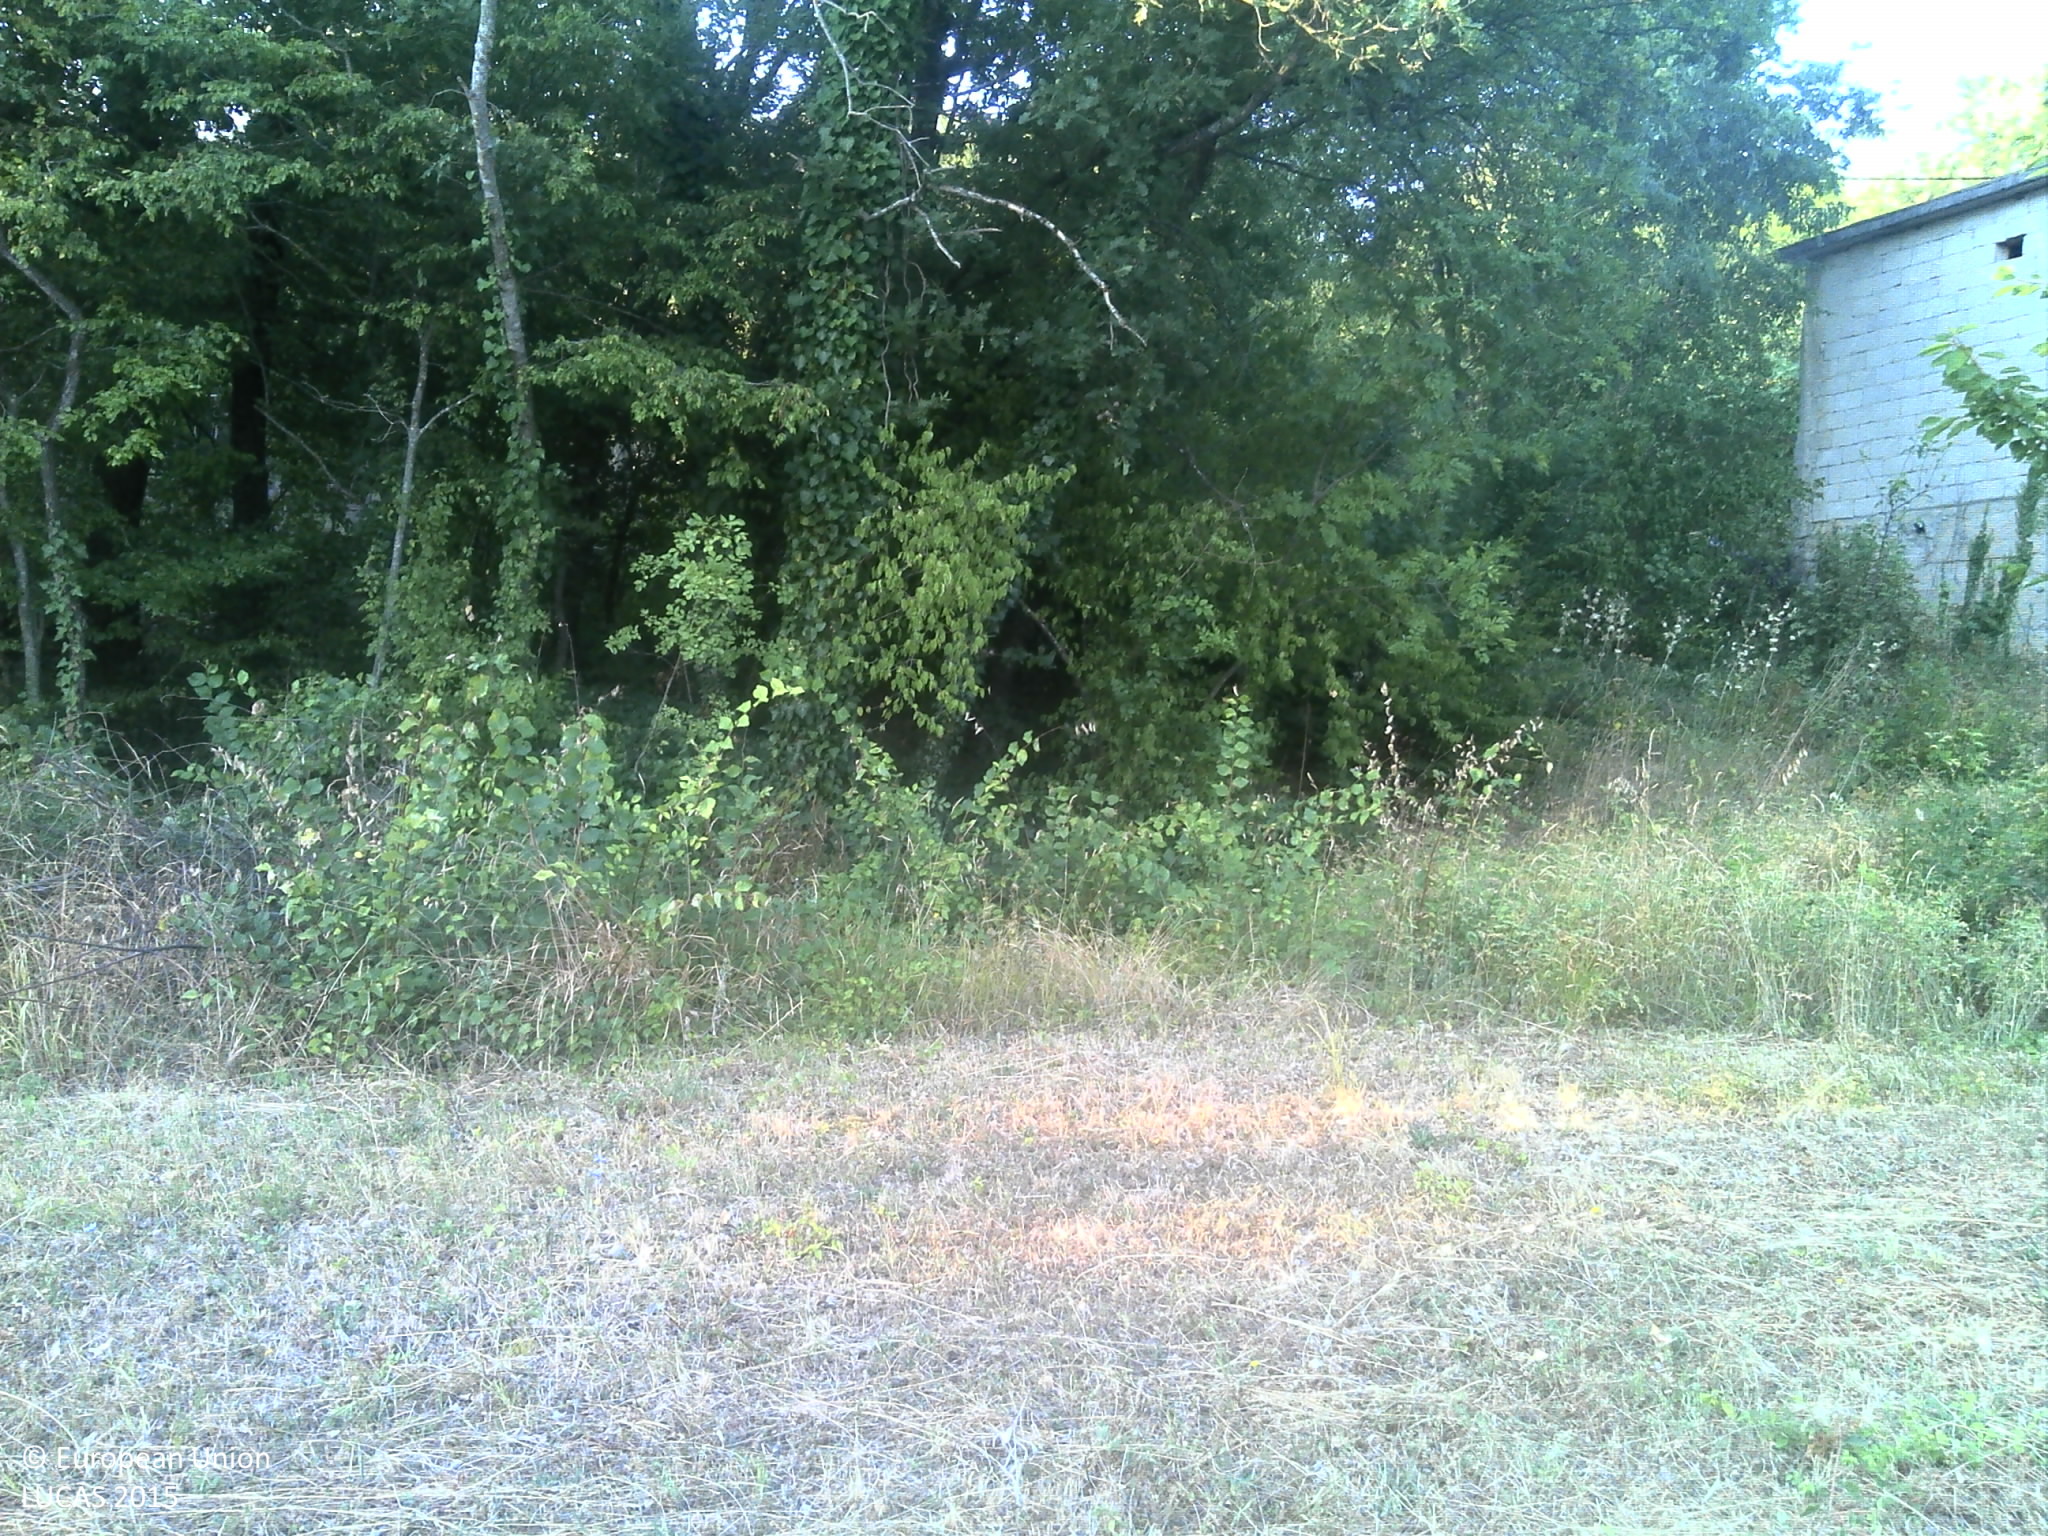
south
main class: Grassland
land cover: Grassland without tree/shrub cover
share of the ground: > 75 %
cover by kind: herbaceous plants 95 %, shrubs 5 %
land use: Agriculture (excluding fallow land and kitchen gardens)
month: July
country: HR
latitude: 43.4145
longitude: 17.1671
